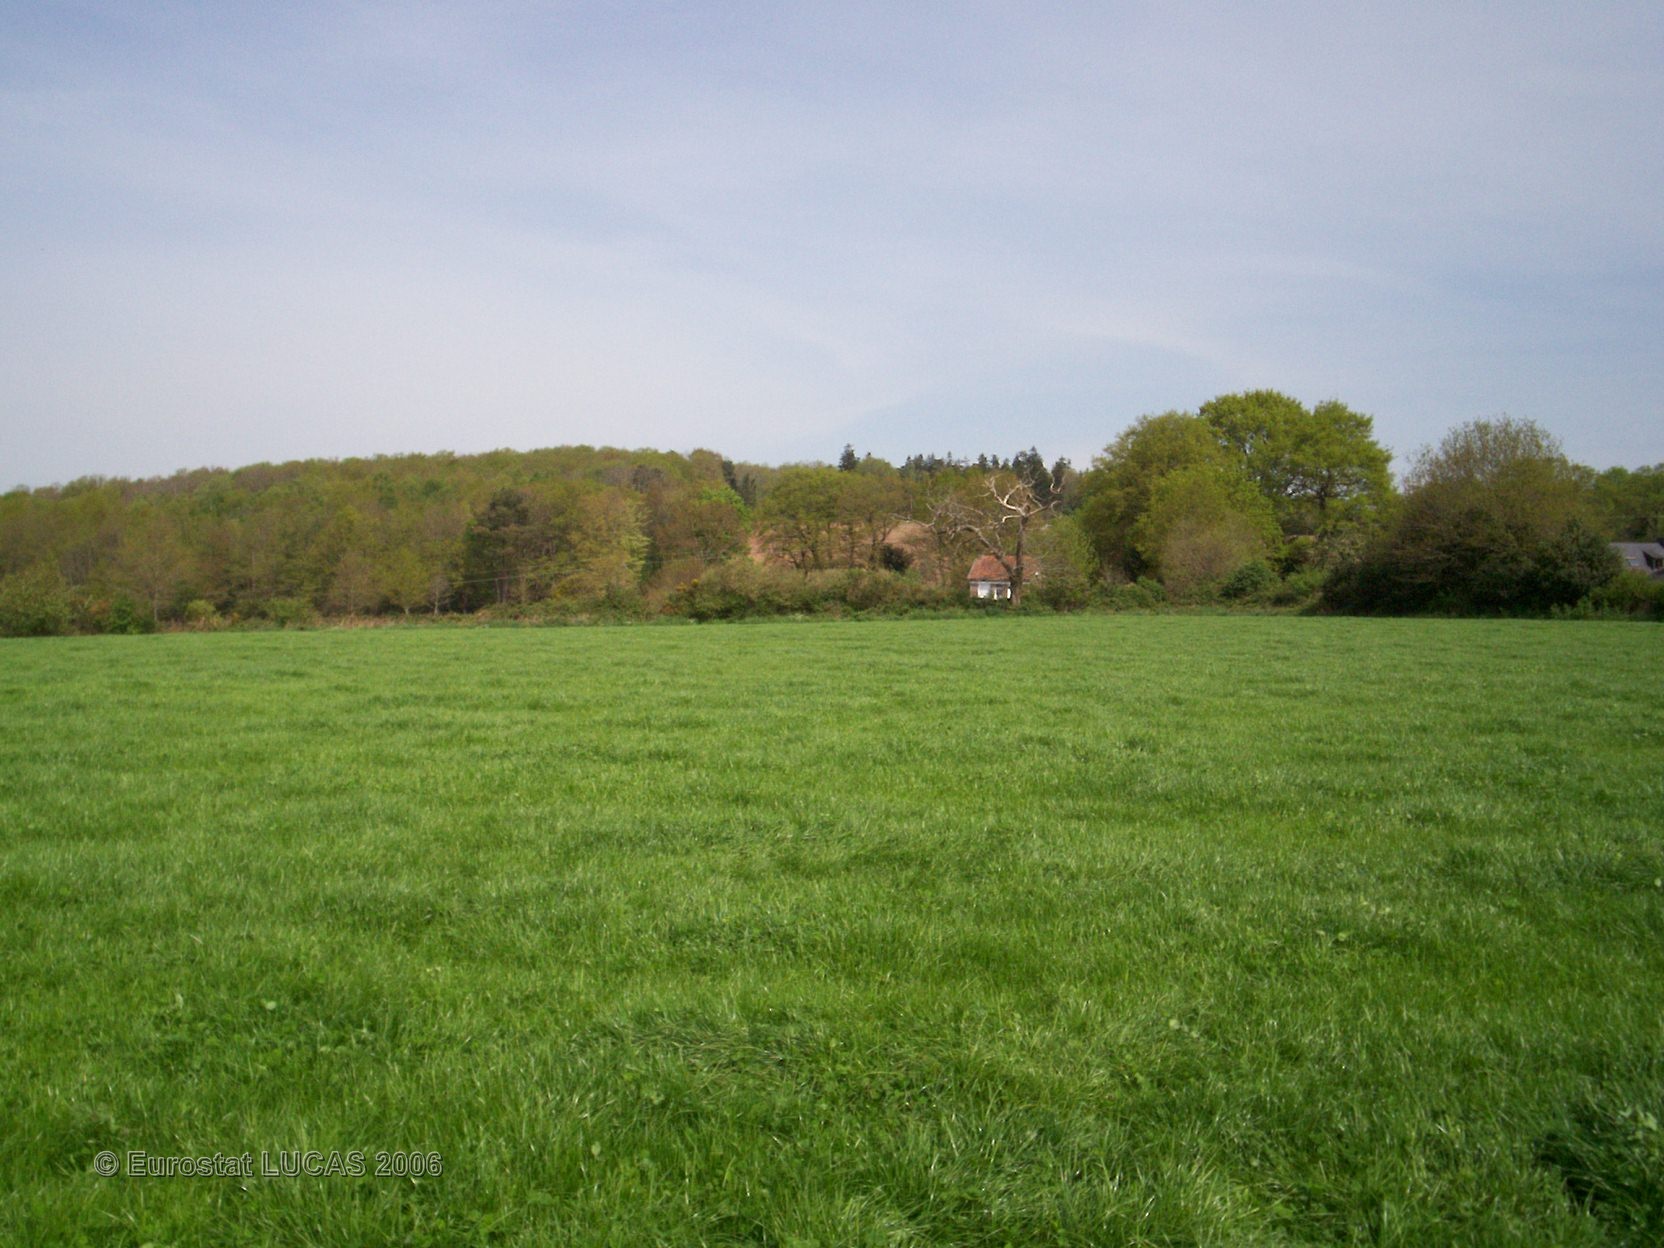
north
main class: Grassland
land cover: Grassland without tree/shrub cover
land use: Agriculture (excluding fallow land and kitchen gardens)
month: May
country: FR
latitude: 47.7132
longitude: -2.3046
